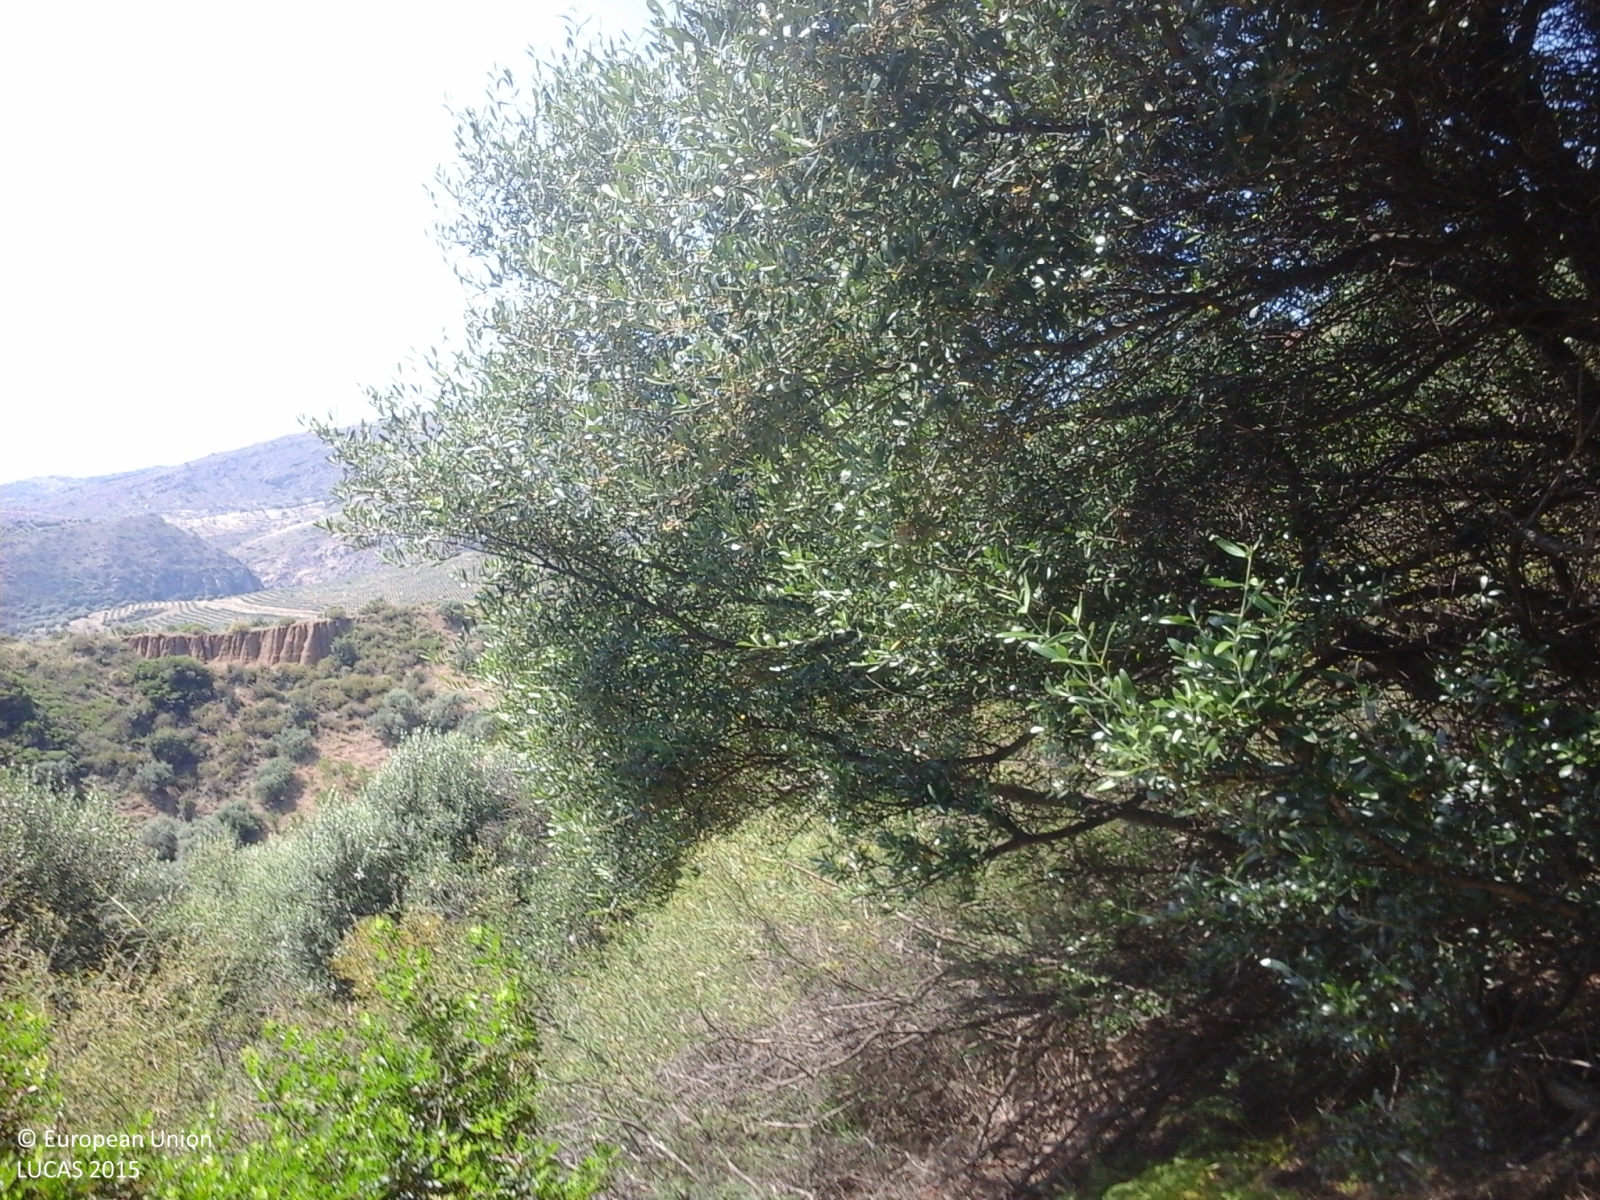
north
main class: Woodland
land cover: Broadleaved woodland
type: broadleaved evergreen forest
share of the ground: > 75 %
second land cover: Grassland without tree/shrub cover
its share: > 75 %
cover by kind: broadleaved forest trees 45 %, shrubs 40 %, herbaceous plants 15 %
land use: Forestry
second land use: Agriculture (excluding fallow land and kitchen gardens)
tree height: > 5 m
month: June
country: IT
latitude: 37.9297
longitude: 14.1464
